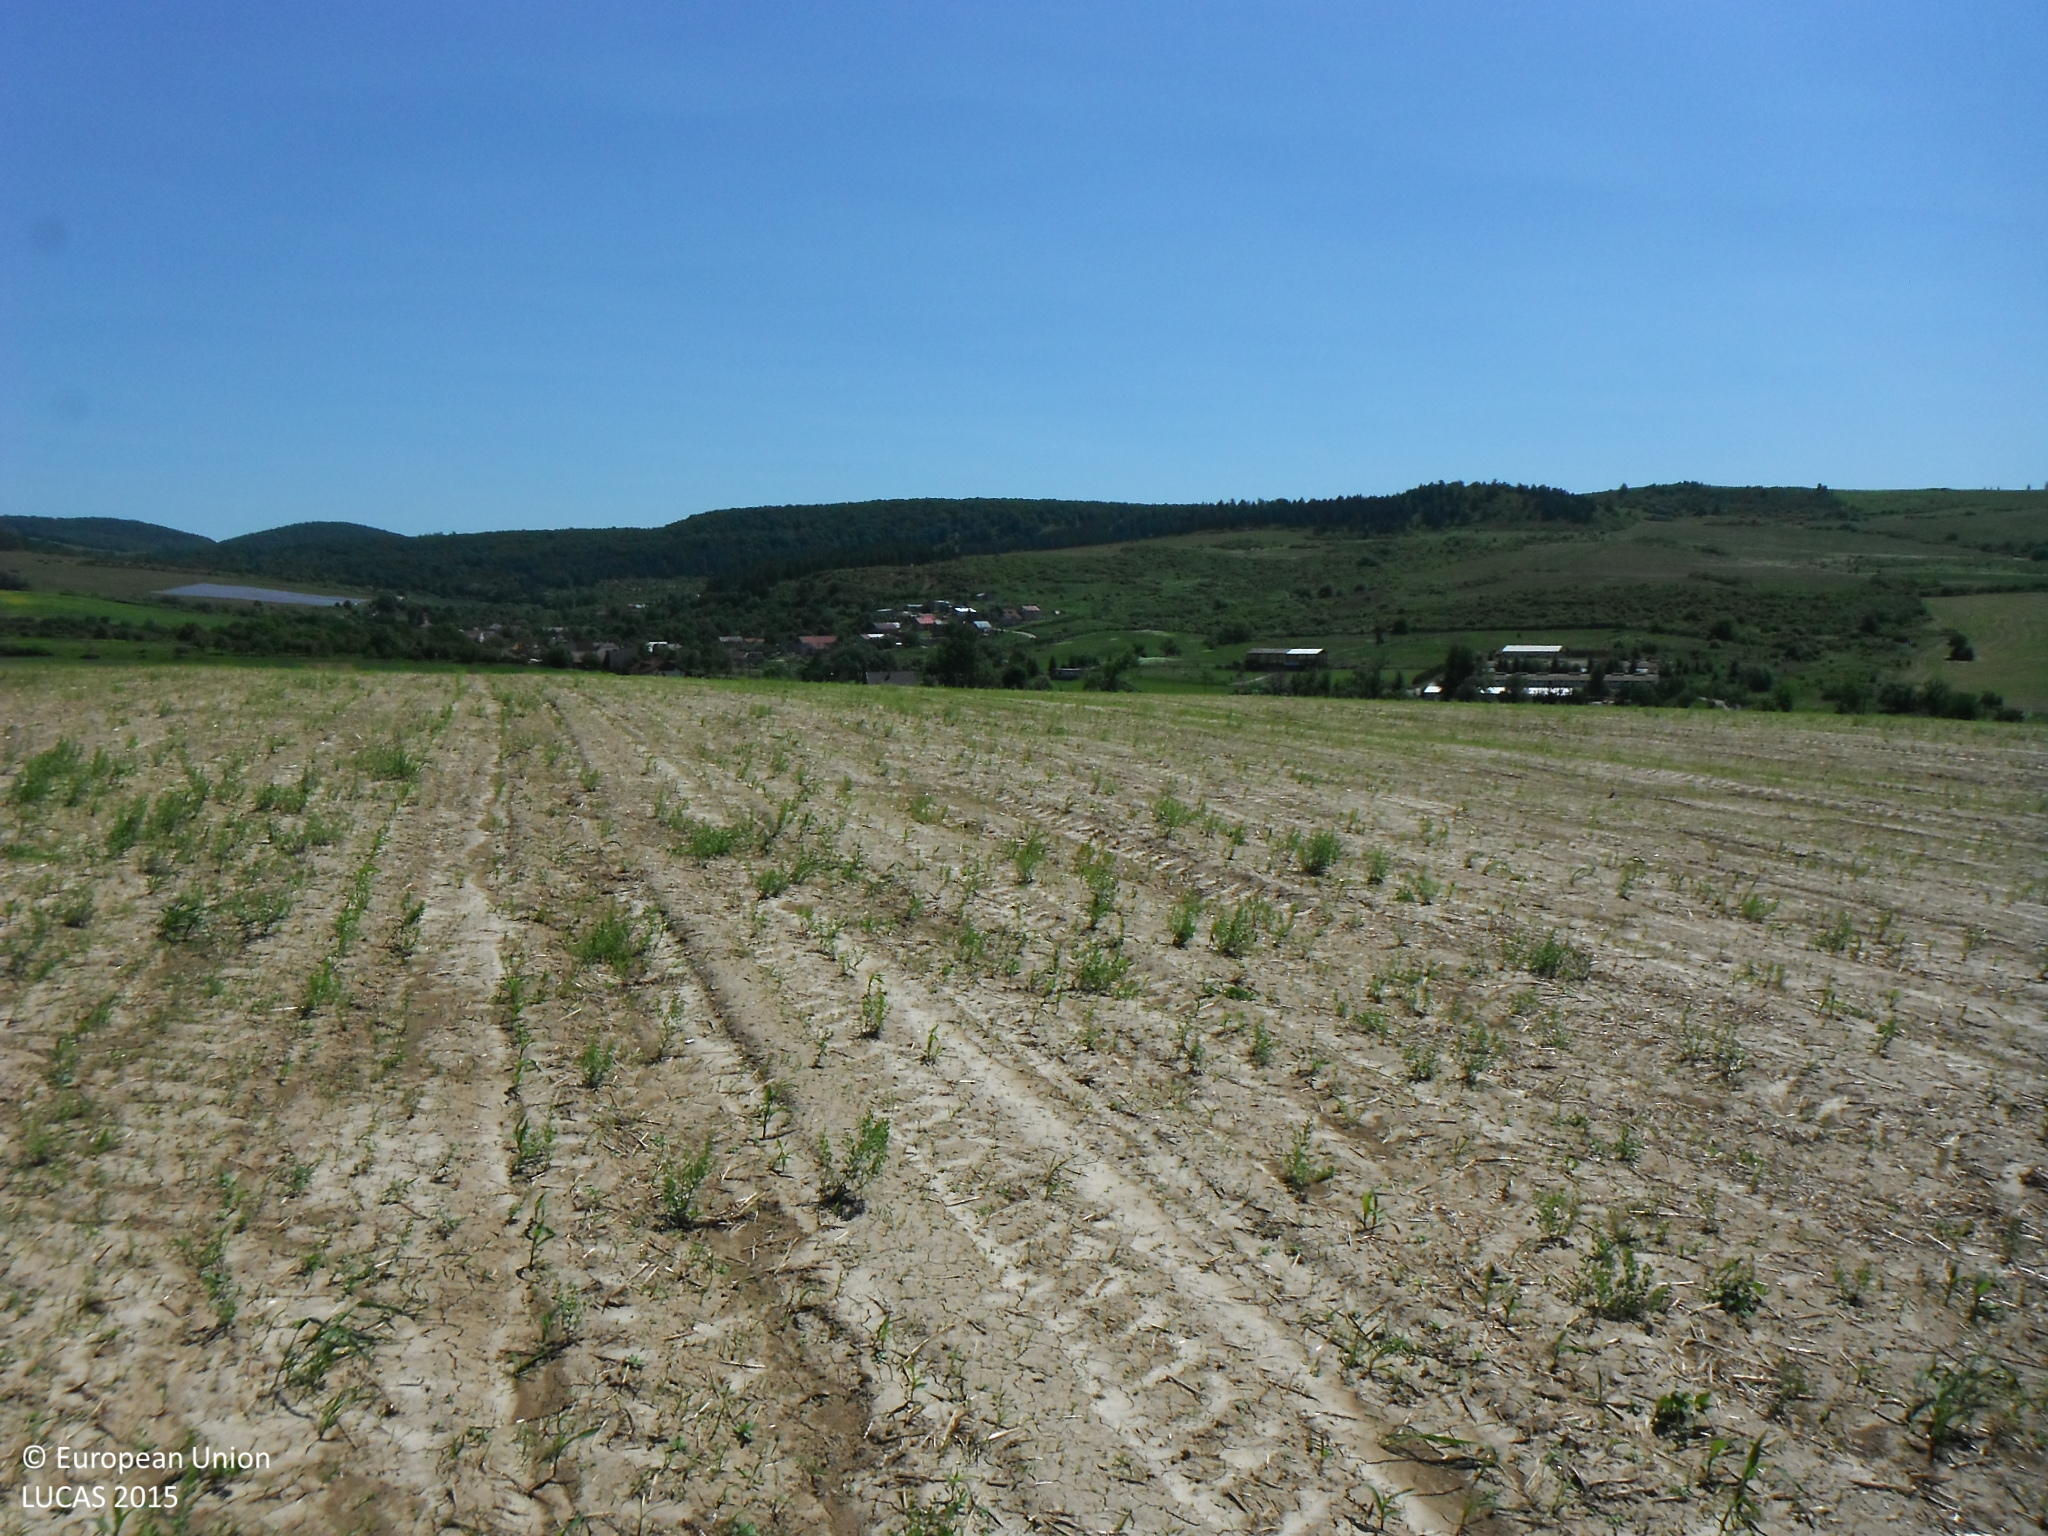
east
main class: Cropland
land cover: Maize
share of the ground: < 10 %
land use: Agriculture (excluding fallow land and kitchen gardens)
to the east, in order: Maize
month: June
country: SK
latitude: 48.8531
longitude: 21.3442
